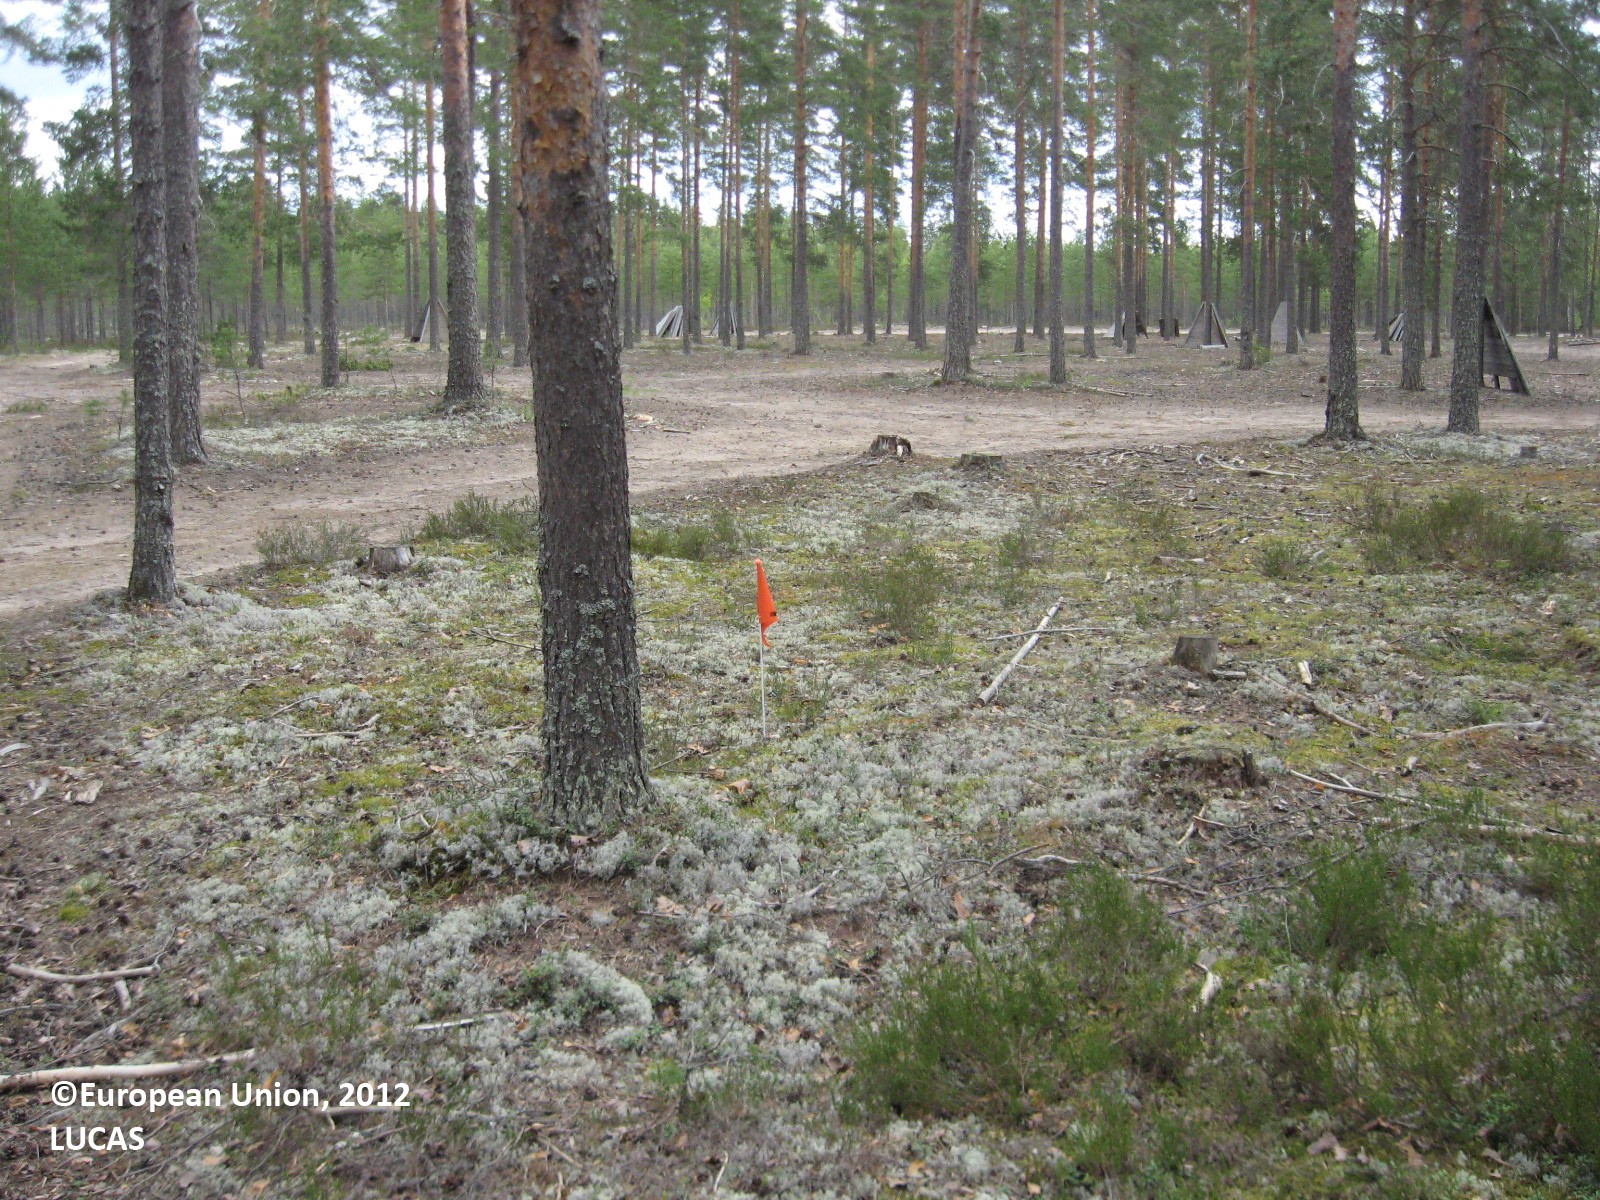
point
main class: Woodland
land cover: Pine dominated coniferous woodland
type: boreal forest
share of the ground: 50 - 75 %
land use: Community services
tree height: > 5 m
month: May
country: FI
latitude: 61.7640
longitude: 22.6639
